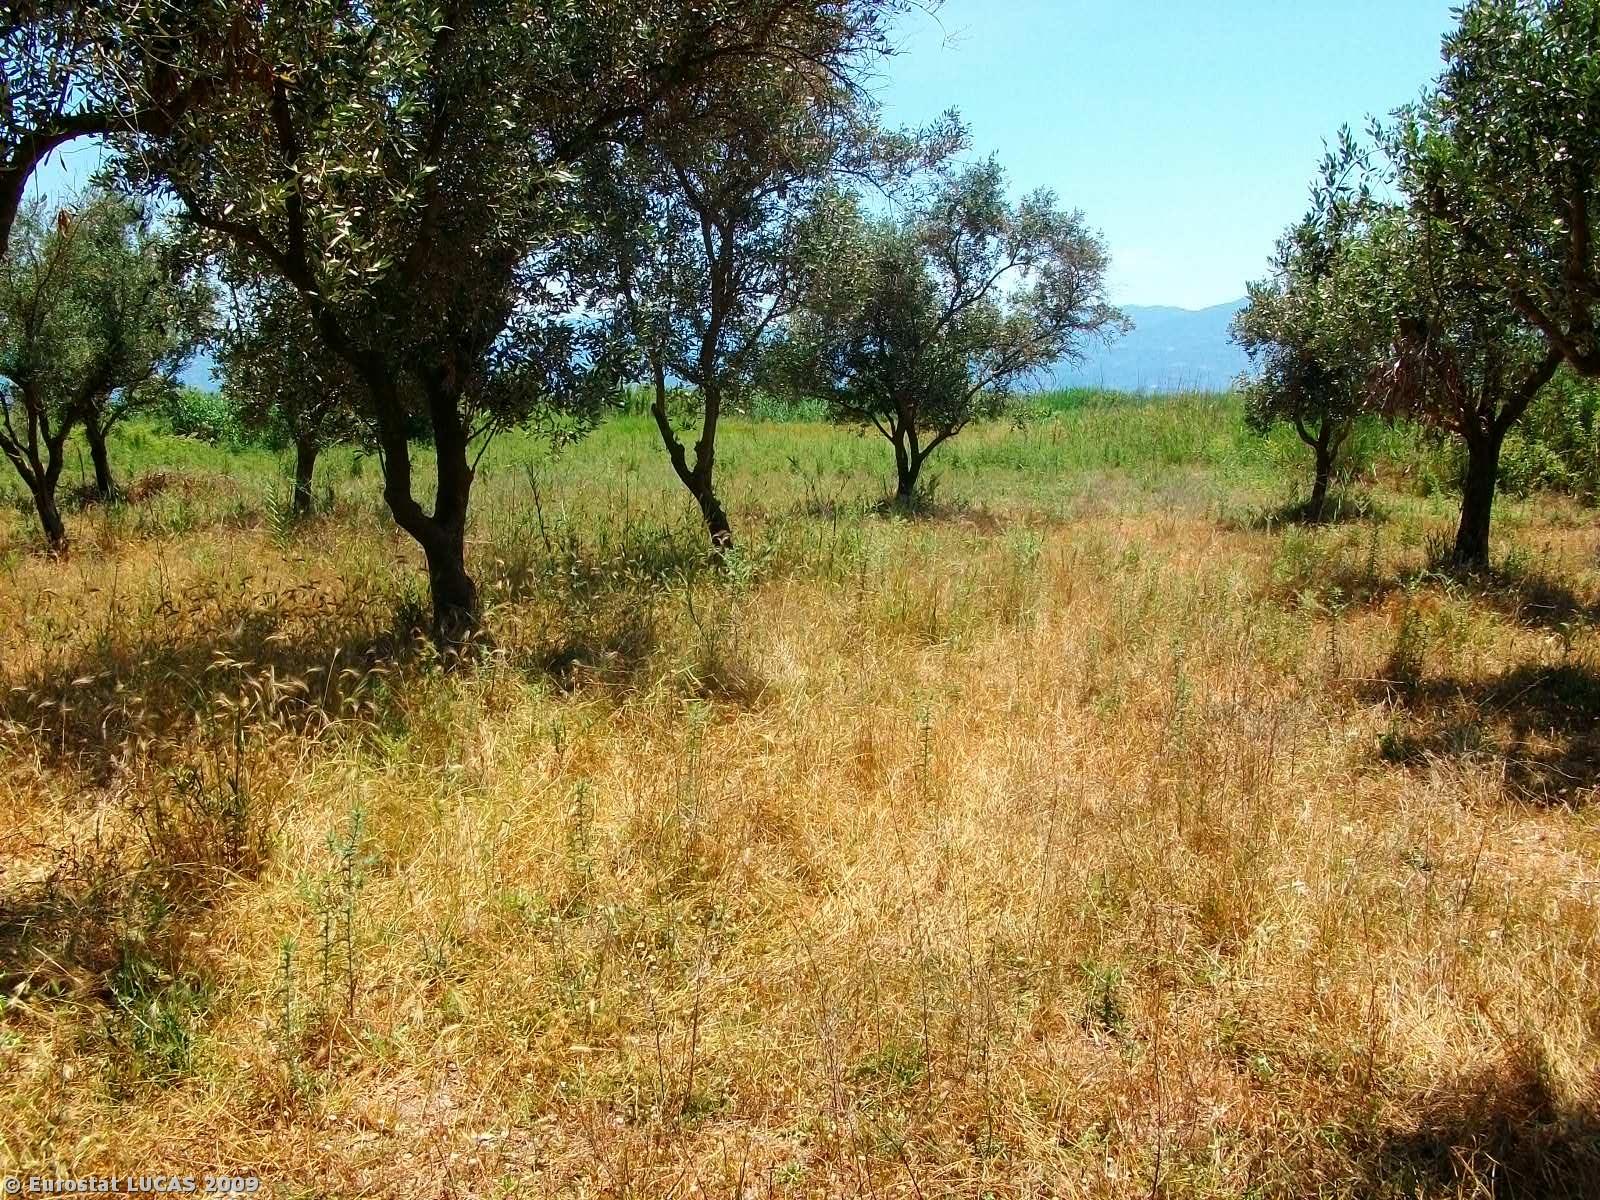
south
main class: Cropland
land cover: Olive groves
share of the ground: 50 - 75 %
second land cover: Grassland with sparse tree/shrub cover
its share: > 75 %
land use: Agriculture (excluding fallow land and kitchen gardens)
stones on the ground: < 10 %
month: June
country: GR
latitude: 38.6010
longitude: 21.5102
